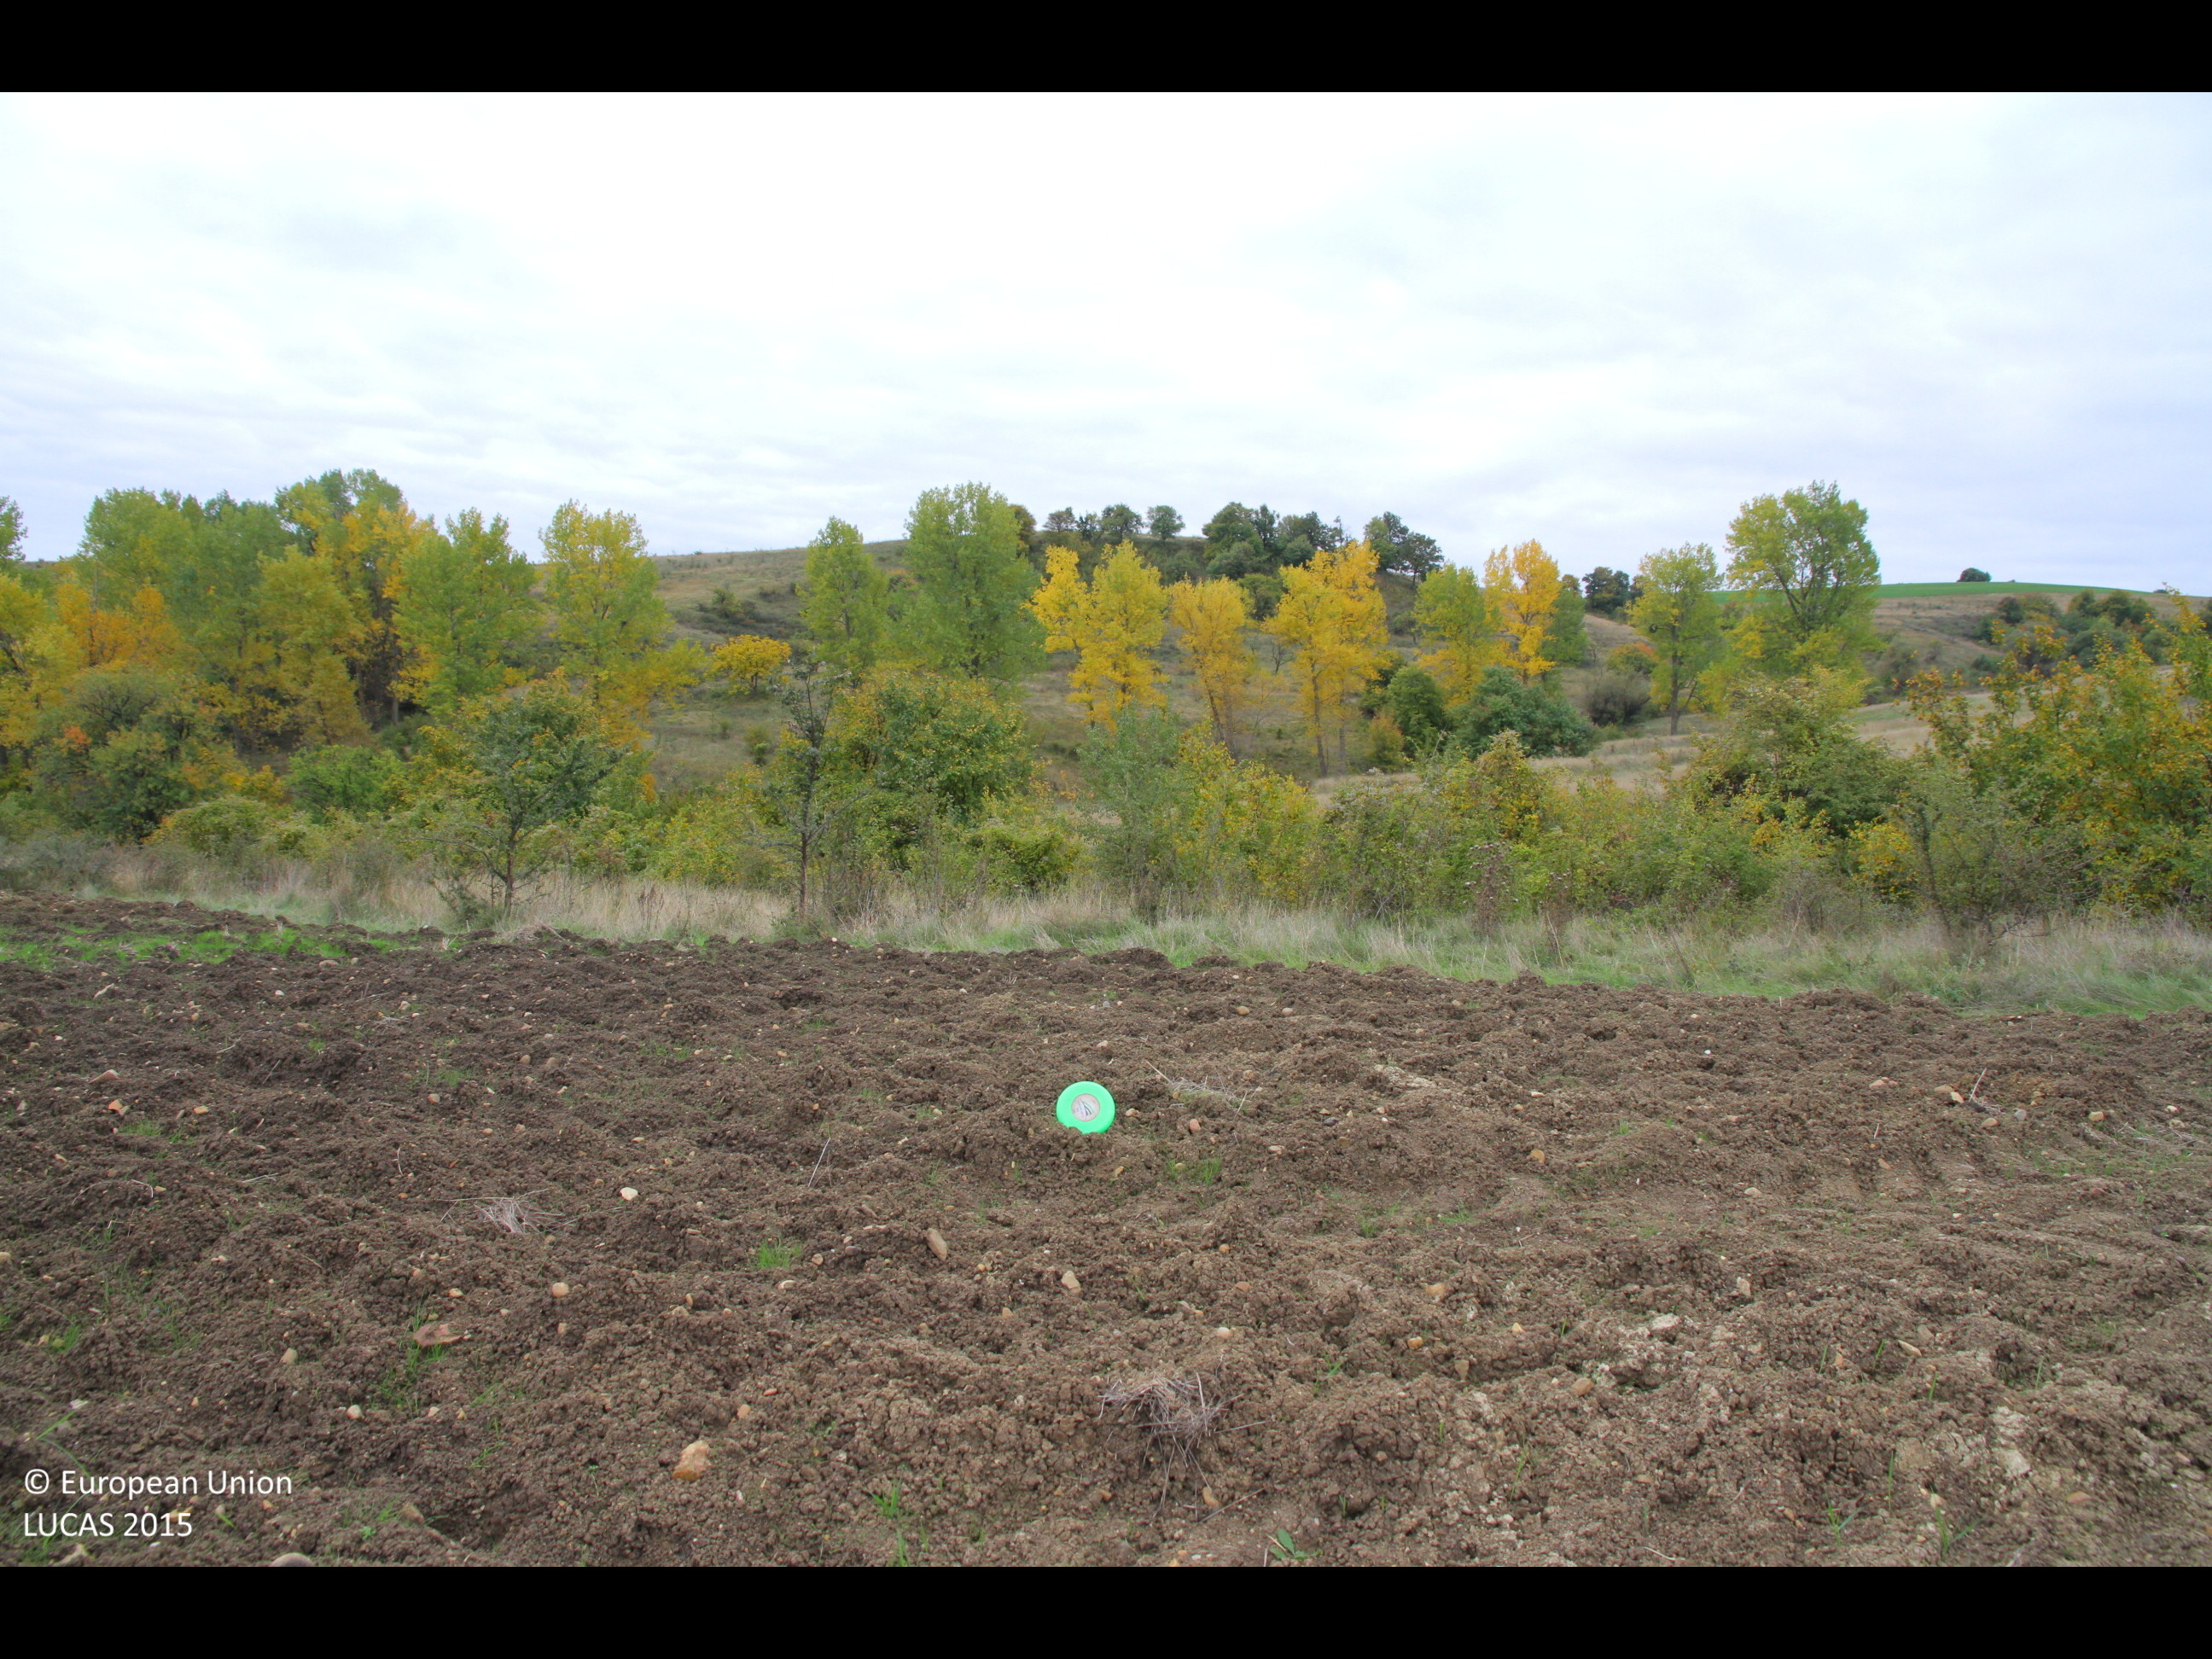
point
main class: Cropland
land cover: Common wheat
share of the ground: < 10 %
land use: Agriculture (excluding fallow land and kitchen gardens)
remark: Harvested field
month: October
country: BG
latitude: 43.1278
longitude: 27.1665
